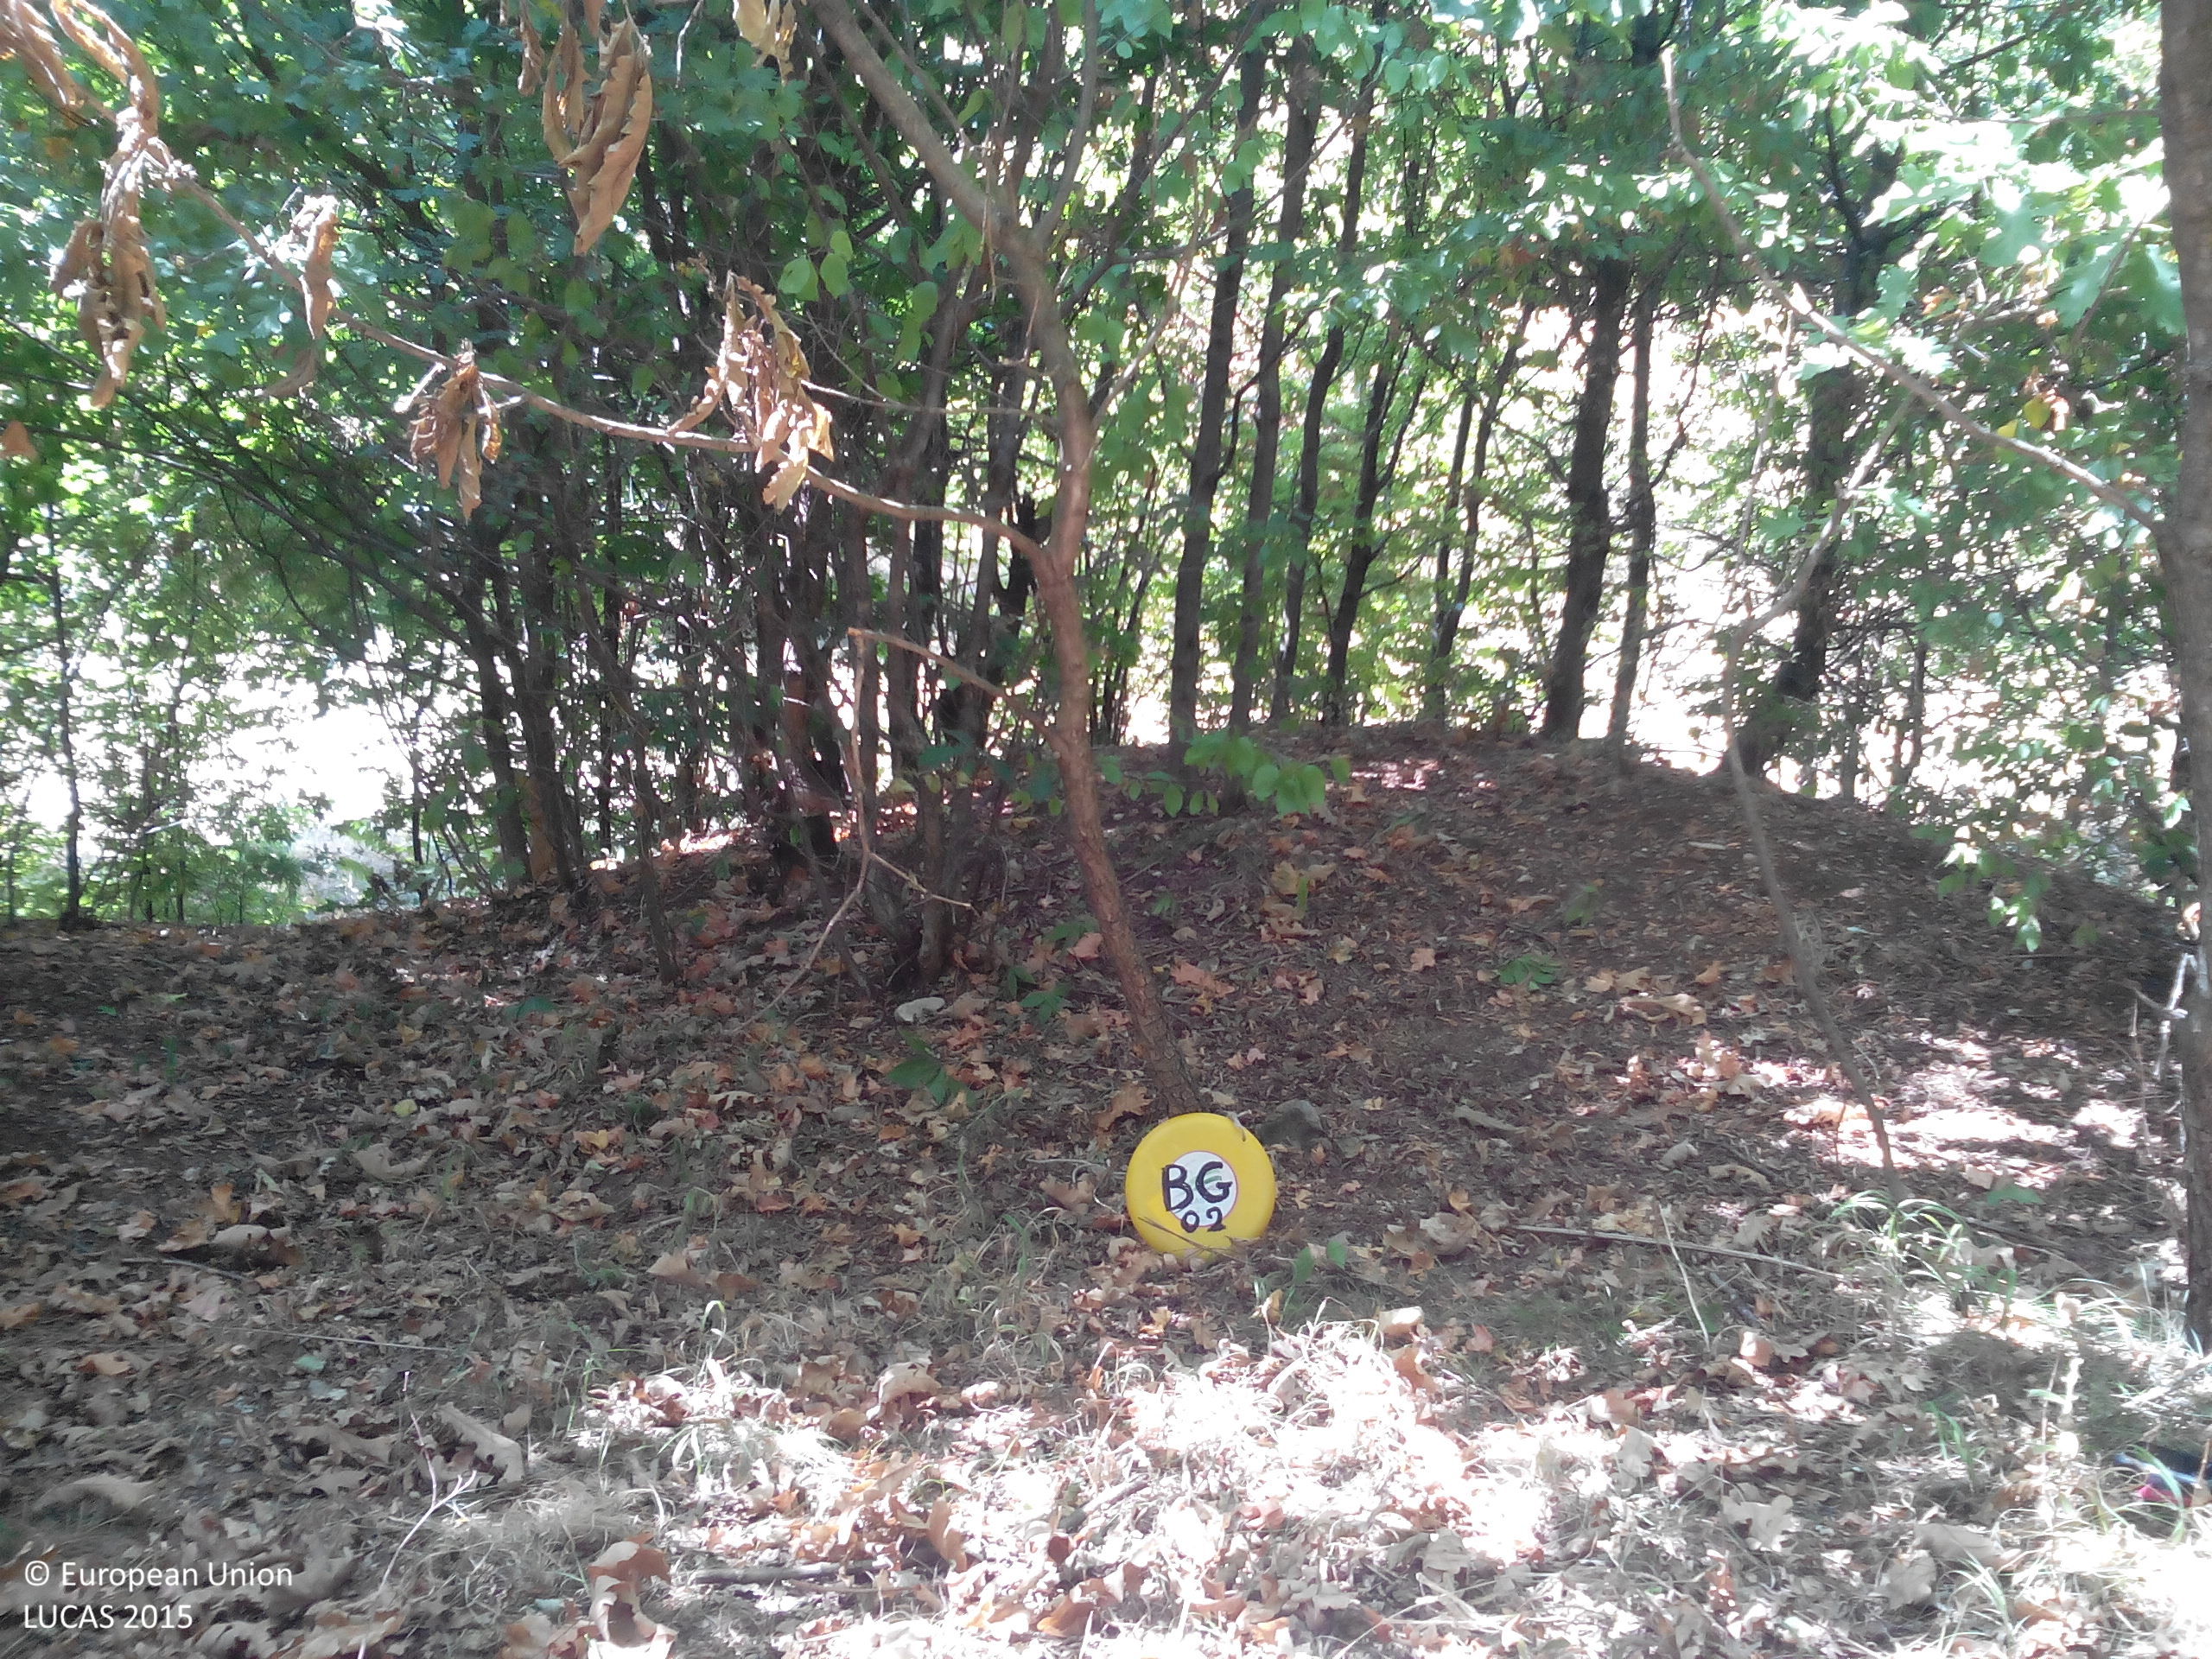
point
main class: Woodland
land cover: Broadleaved woodland
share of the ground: > 75 %
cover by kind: broadleaved forest trees 90 %, shrubs 5 %, herbaceous plants 5 %
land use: Forestry
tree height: > 5 m
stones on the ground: 10 - 25 %
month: August
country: BG
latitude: 43.2311
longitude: 23.6002
